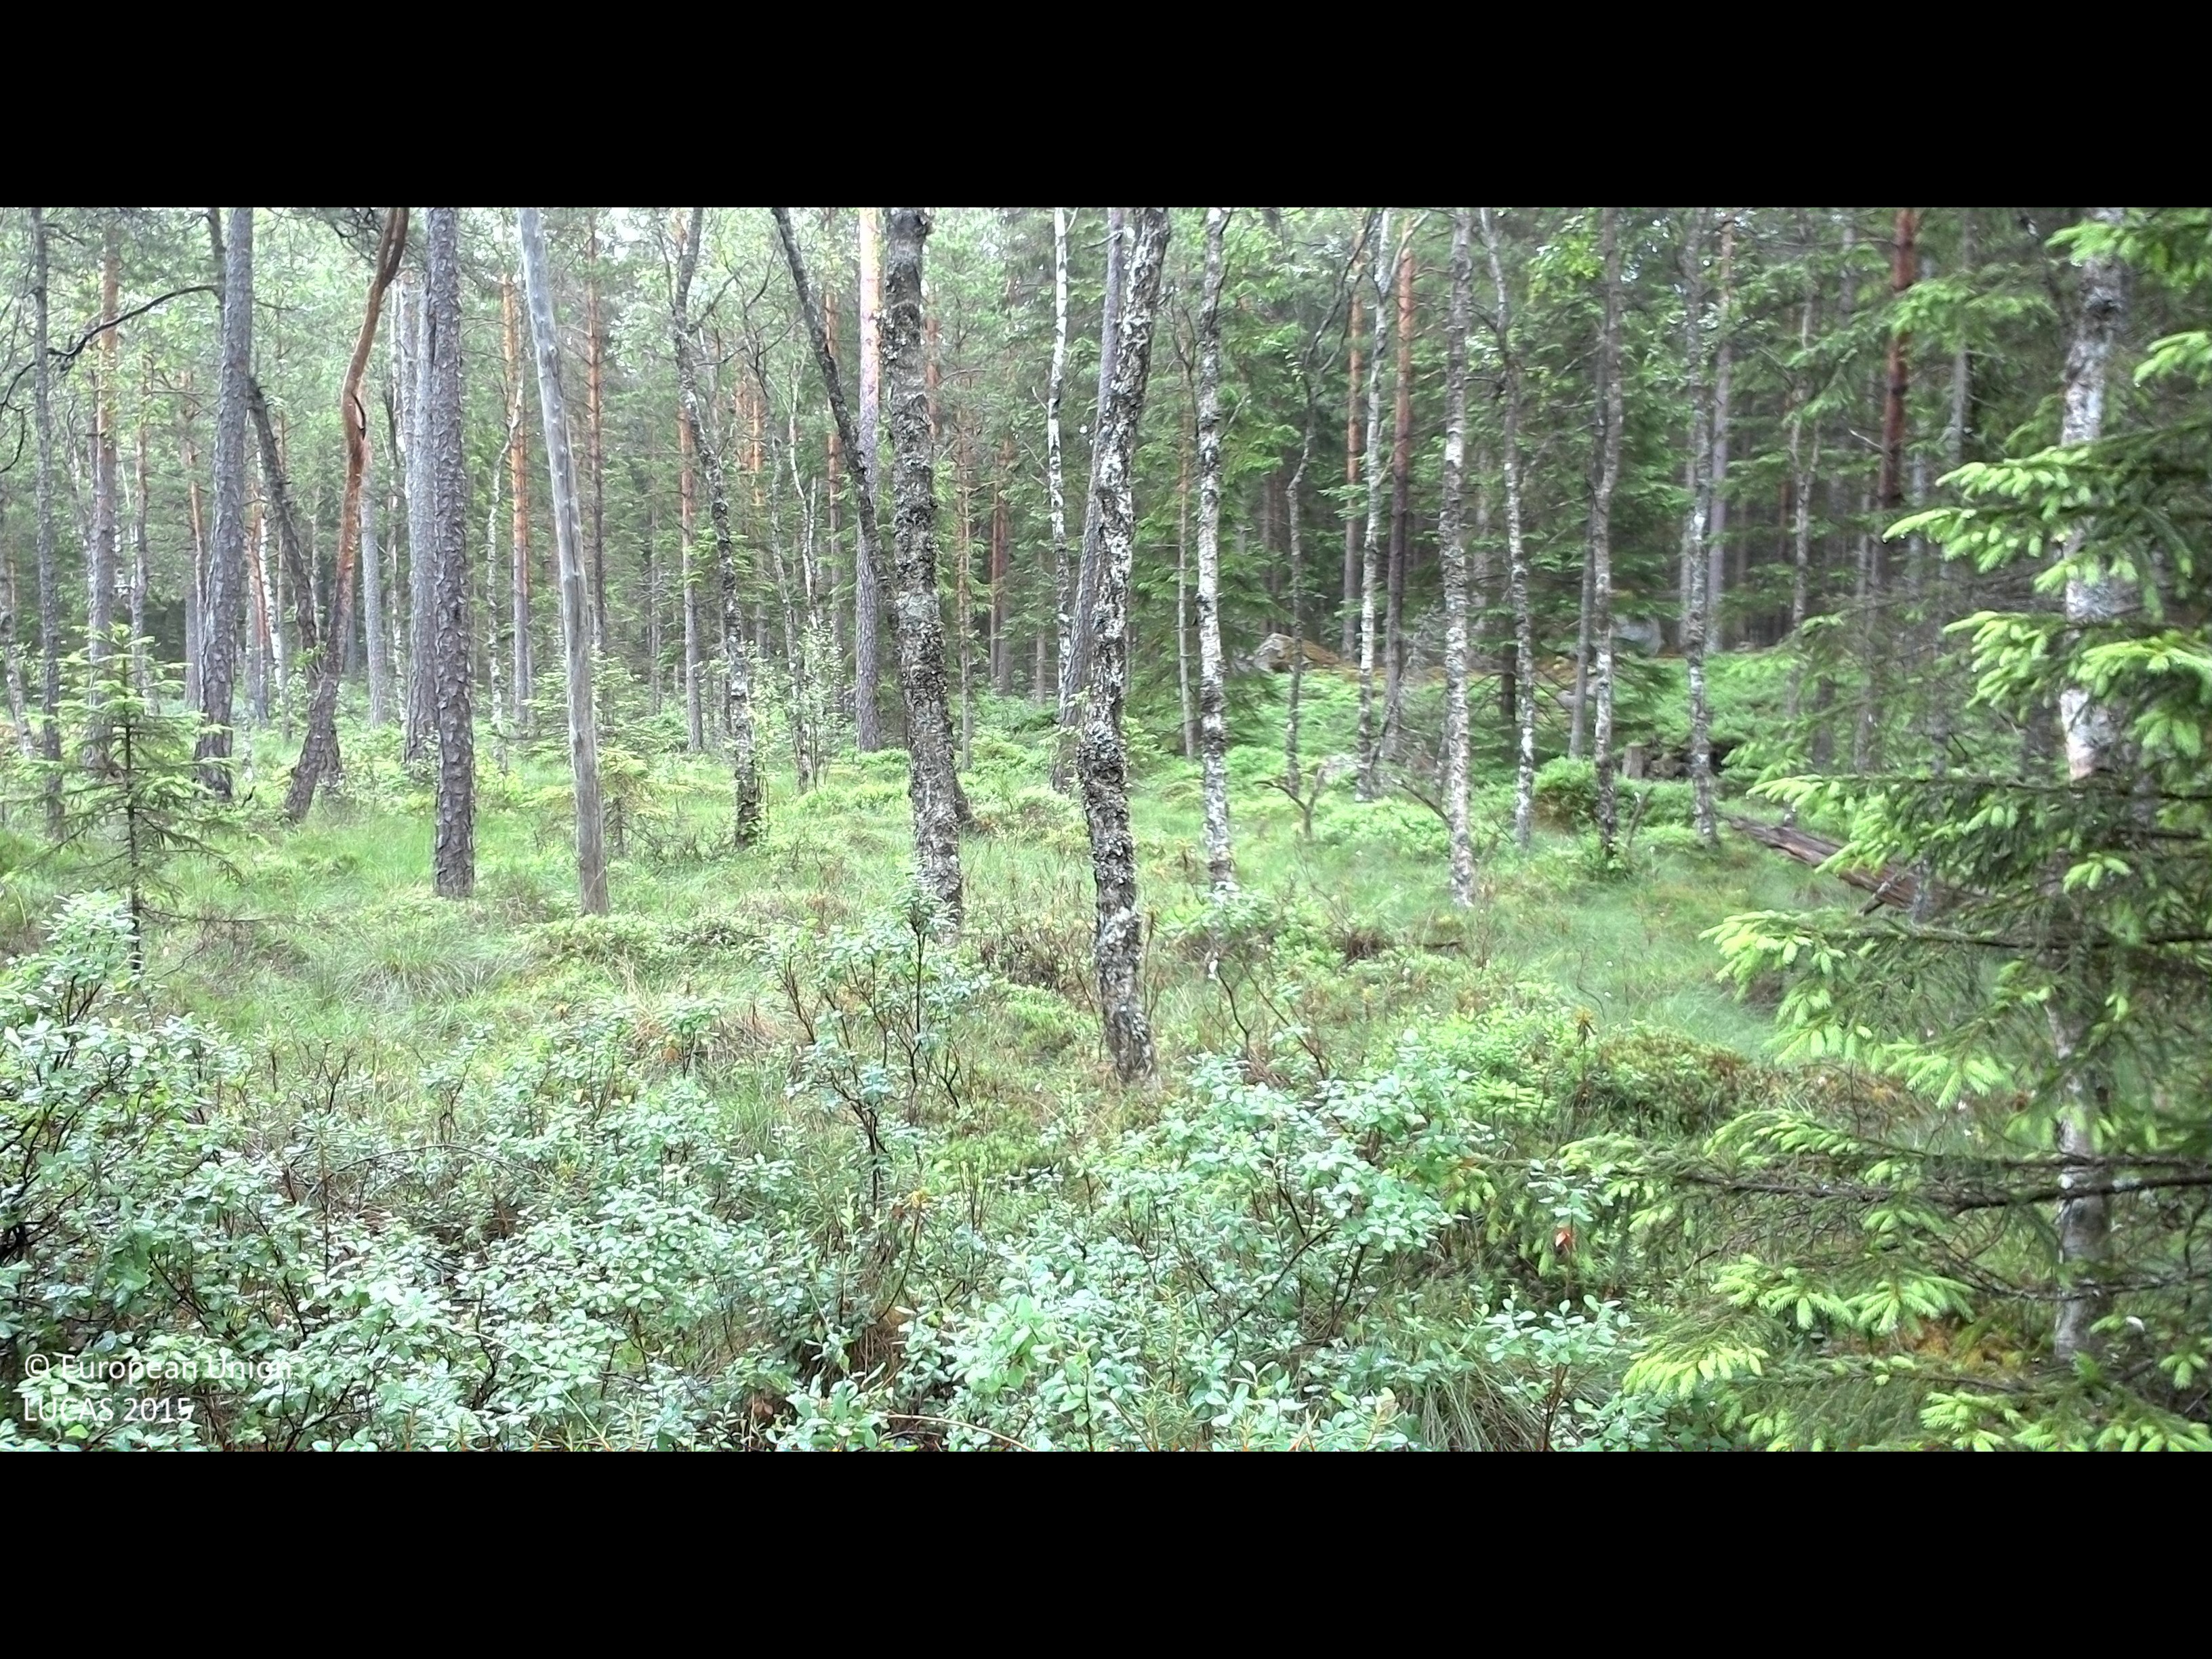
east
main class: Woodland
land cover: Pine dominated mixed woodland
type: boreal forest
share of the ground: 25 - 50 %
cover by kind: coniferous forest trees 35 %, shrubs 25 %, lichens and mosses 20 %, broadleaved forest trees 15 %, herbaceous plants 5 %
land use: Forestry
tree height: > 5 m
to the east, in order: Pine dominated mixed woodland; Spruce dominated coniferous woodland; Pine dominated coniferous woodland
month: July
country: SE
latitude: 56.5376
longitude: 14.5995
